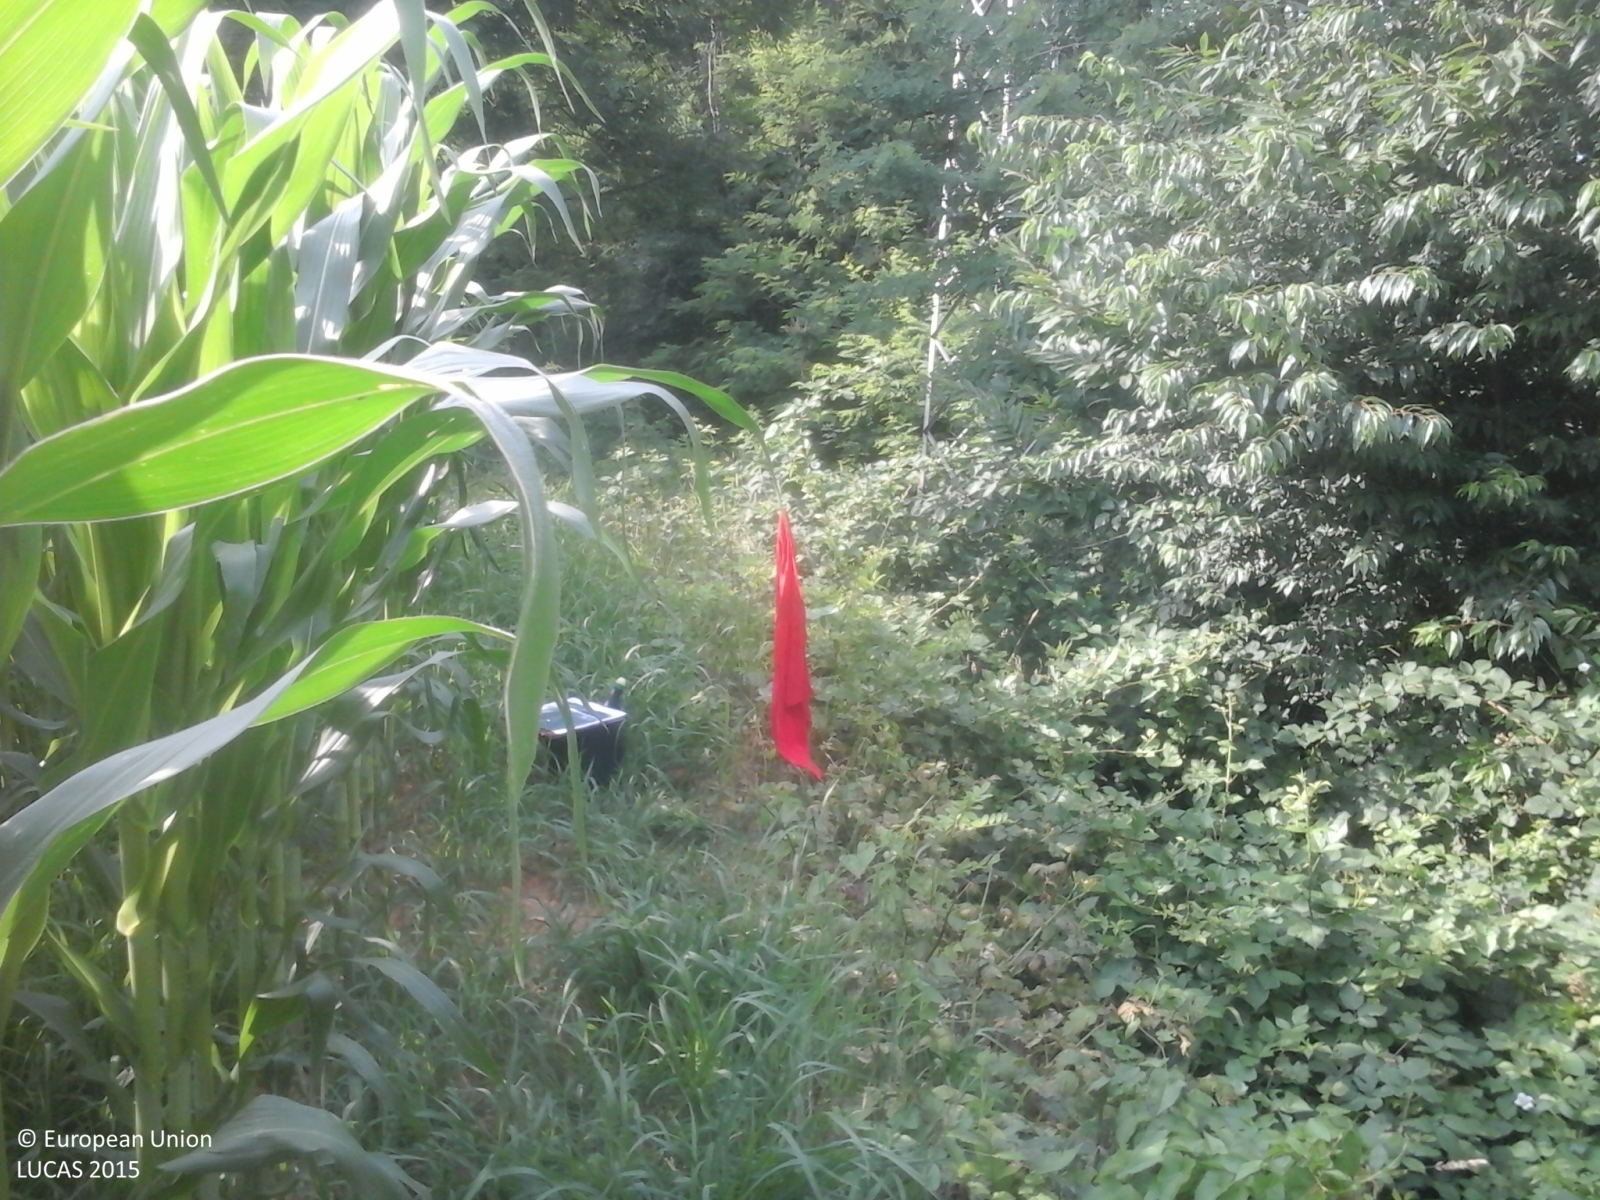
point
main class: Woodland
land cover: Broadleaved woodland
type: thermophilous deciduous forest
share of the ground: > 75 %
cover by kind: broadleaved forest trees 100 %
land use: Forestry
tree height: > 5 m
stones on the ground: < 10 %
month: June
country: IT
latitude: 45.6642
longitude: 9.2952
